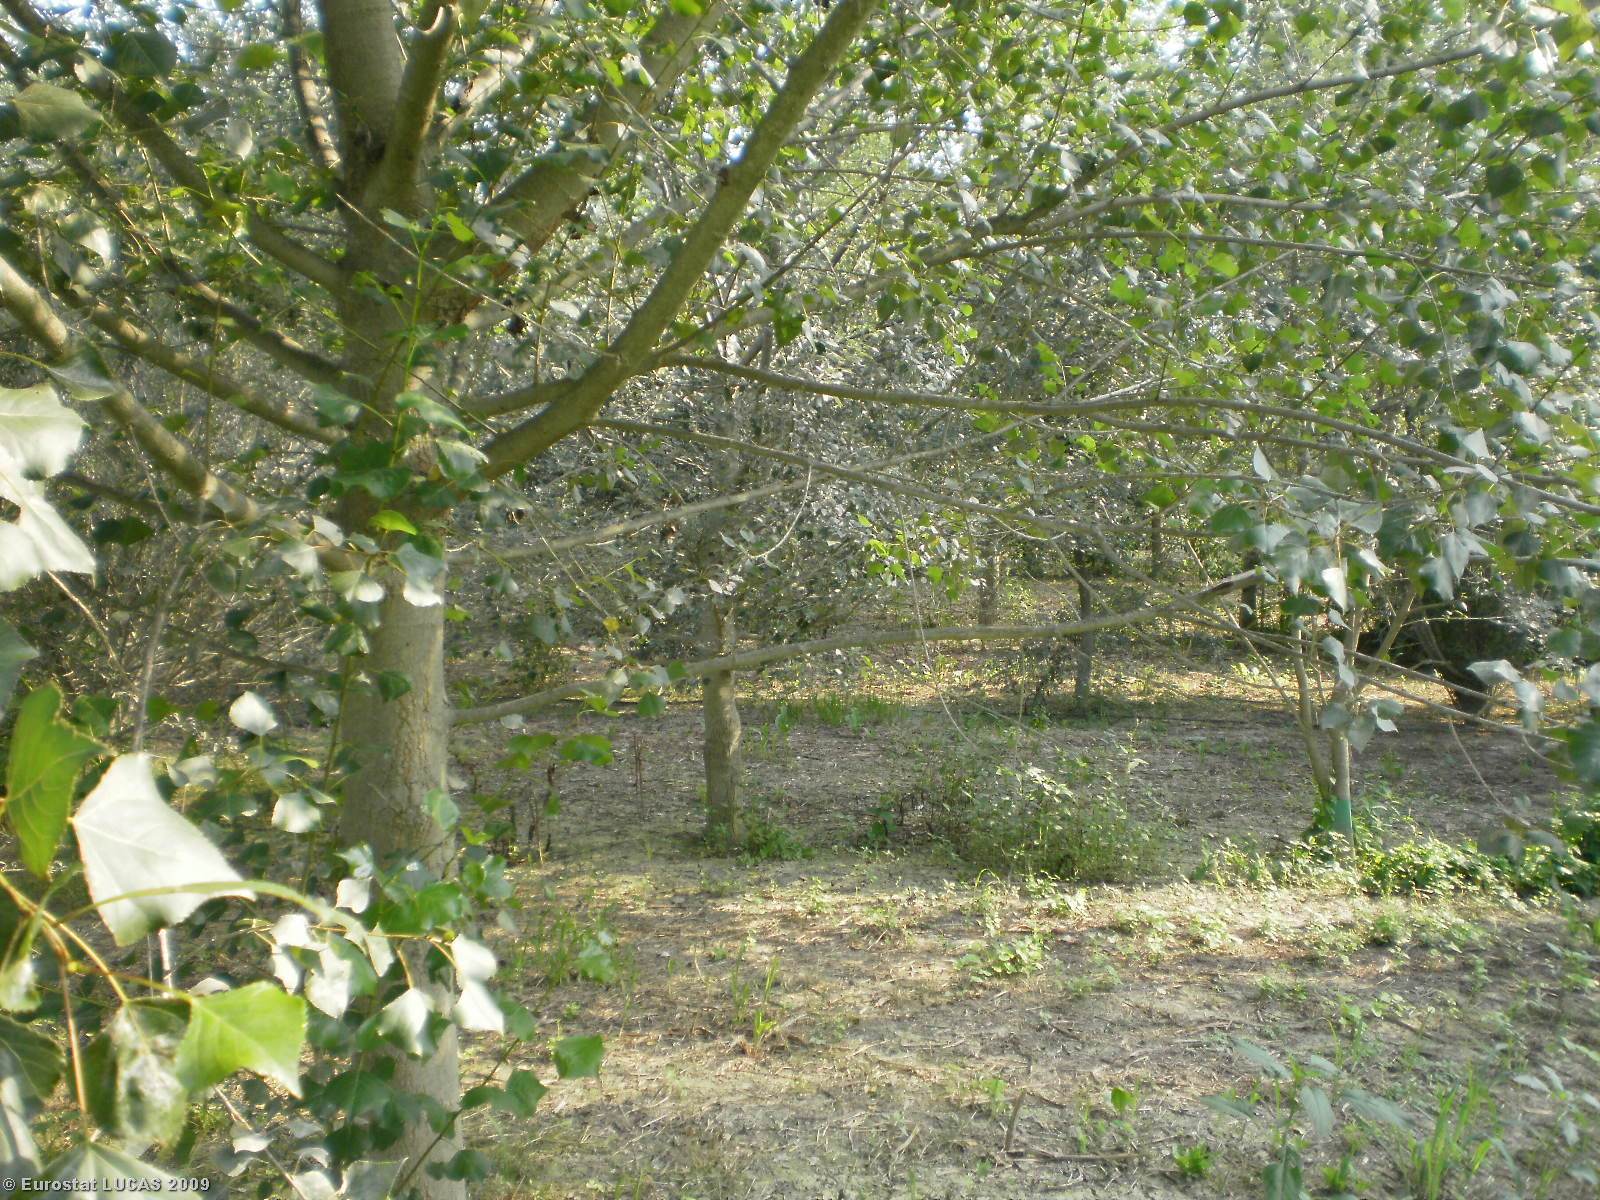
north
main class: Woodland
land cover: Broadleaved woodland
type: non-riverine alder, birch or aspen forest
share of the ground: > 75 %
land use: Forestry
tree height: > 5 m
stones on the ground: < 10 %
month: July
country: IT
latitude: 44.9447
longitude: 10.4427
